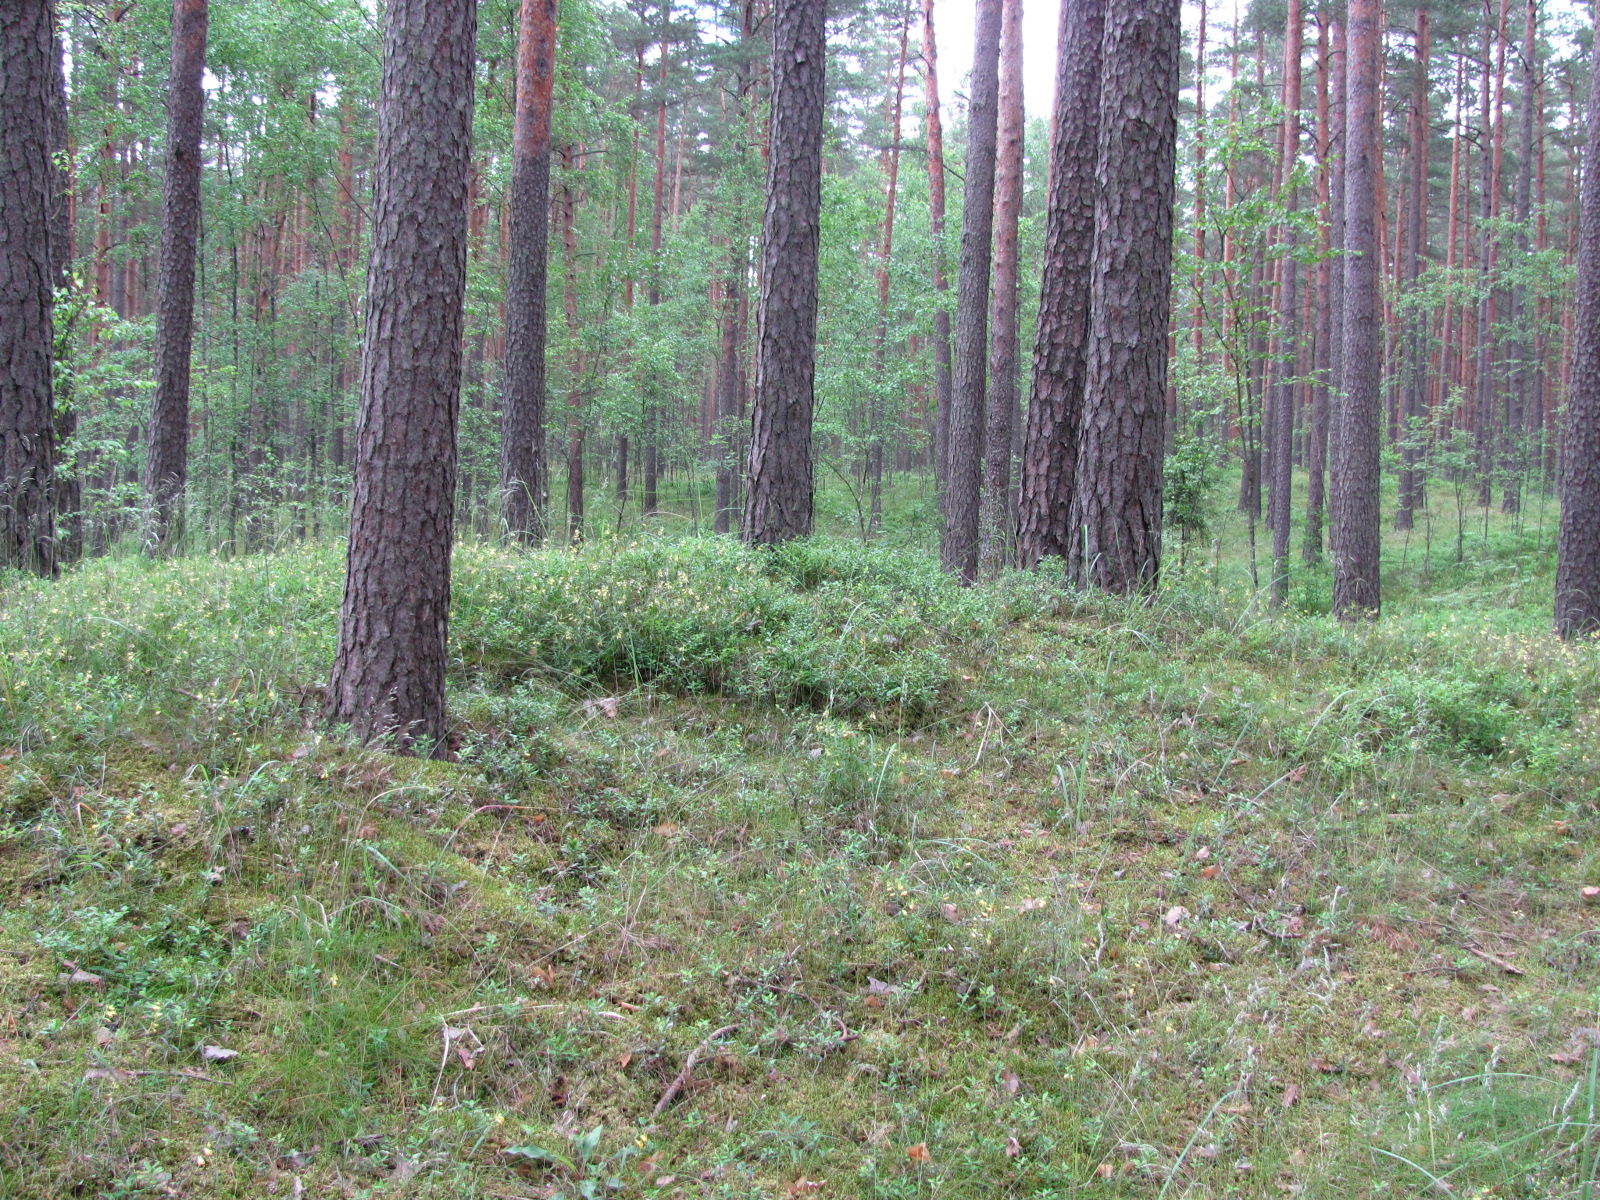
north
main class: Woodland
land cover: Pine dominated coniferous woodland
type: hemiboreal forest and nemoral coniferous forest and mixed broadleaved-coniferous forest
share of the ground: > 75 %
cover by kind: coniferous forest trees 80 %, herbaceous plants 10 %, lichens and mosses 10 %
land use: Forestry
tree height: > 5 m
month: June
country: LV
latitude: 56.9219
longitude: 23.9308
